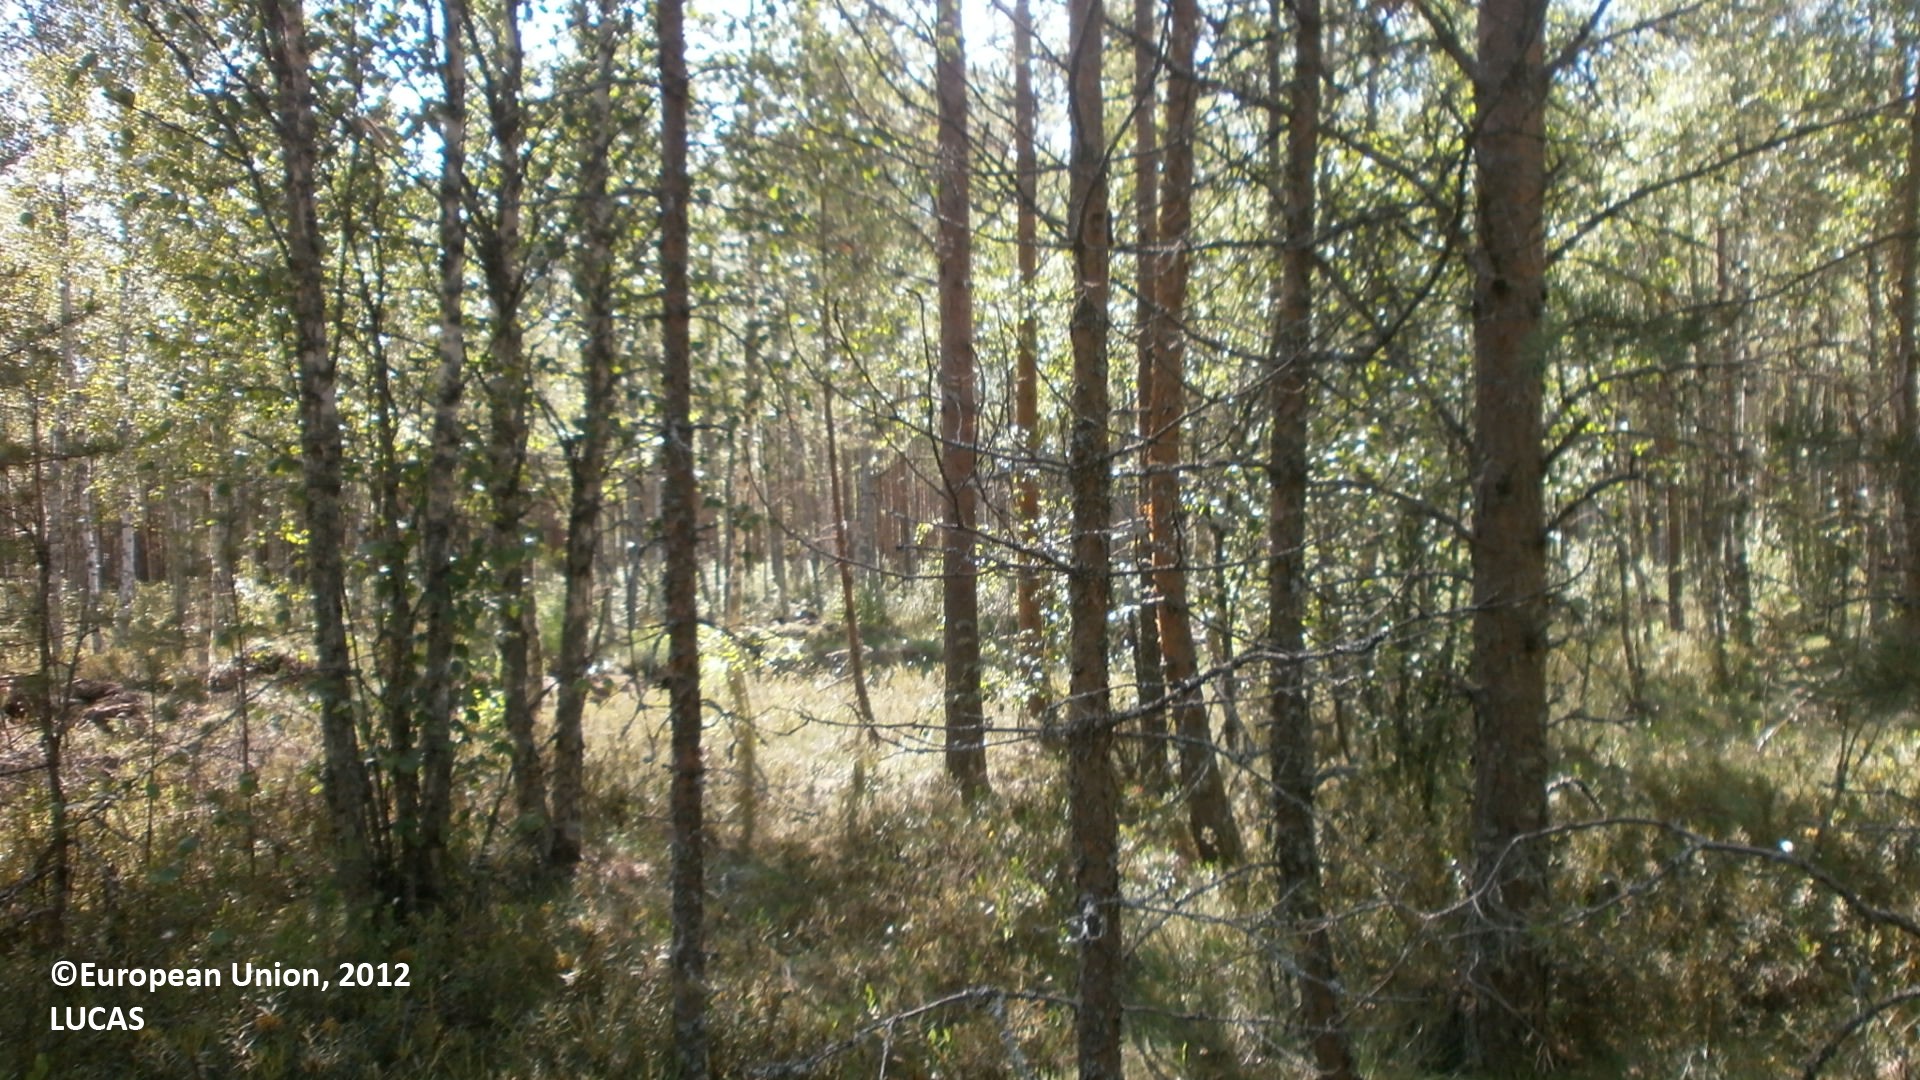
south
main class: Woodland
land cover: Pine dominated mixed woodland
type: mire and swamp forests
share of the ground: 50 - 75 %
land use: Forestry
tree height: > 5 m
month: July
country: FI
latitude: 64.2738
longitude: 24.1681
